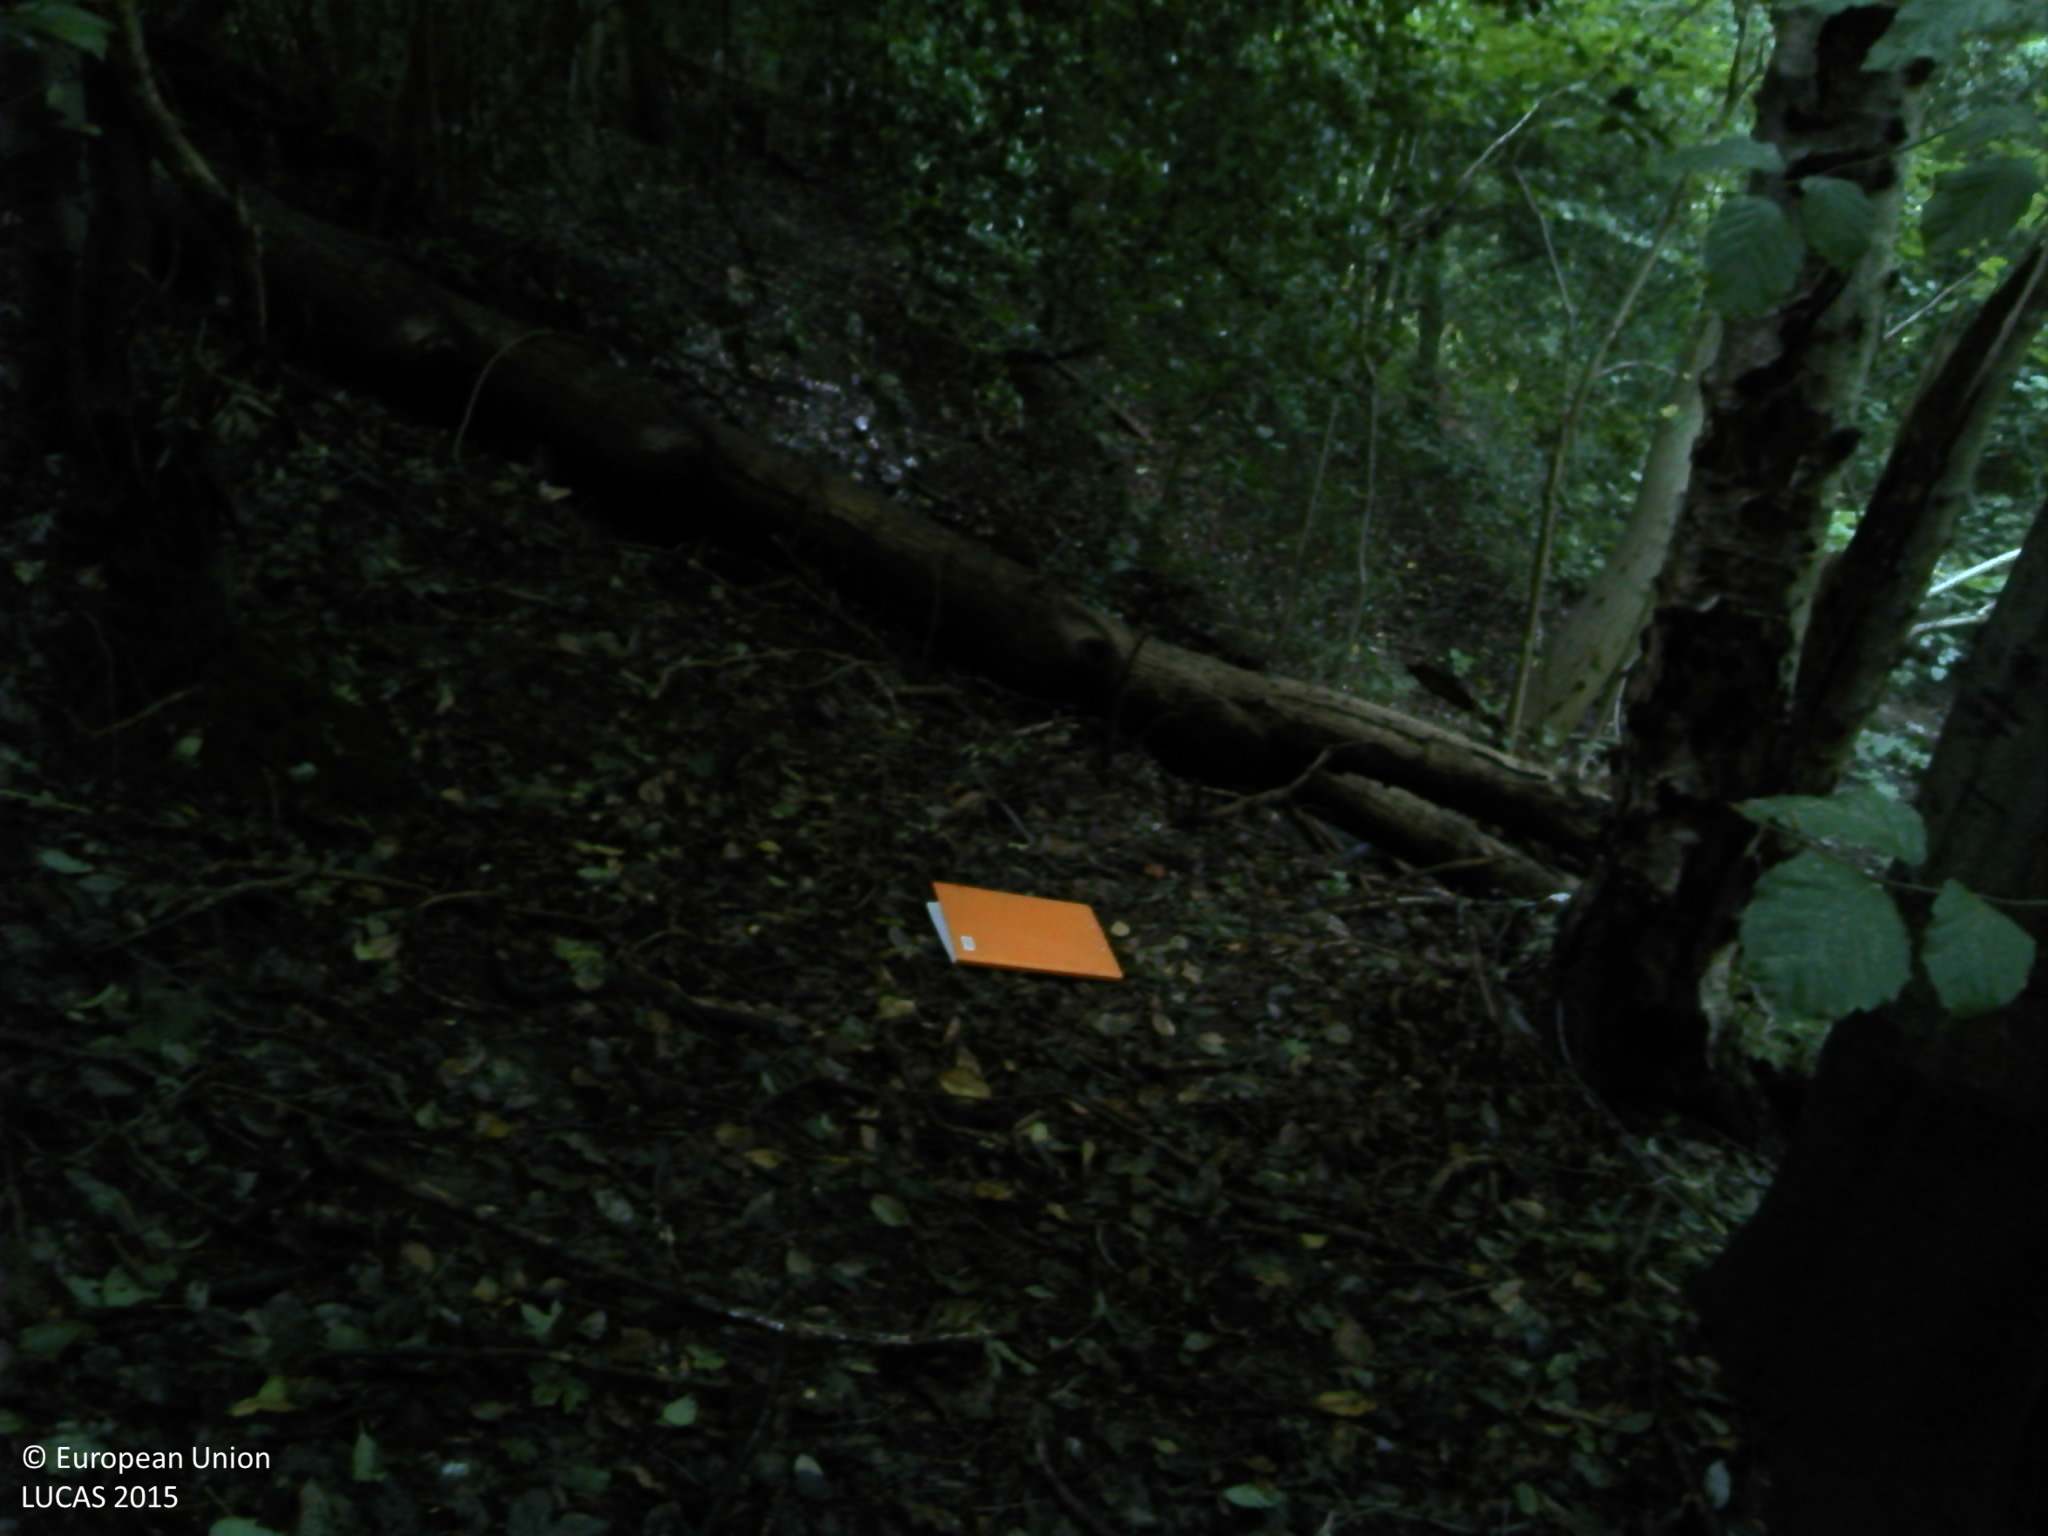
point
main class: Woodland
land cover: Broadleaved woodland
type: beech forest
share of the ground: > 75 %
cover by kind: broadleaved forest trees 100 %
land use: Forestry
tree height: > 5 m
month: June
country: FR
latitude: 49.5175
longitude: 0.3163
